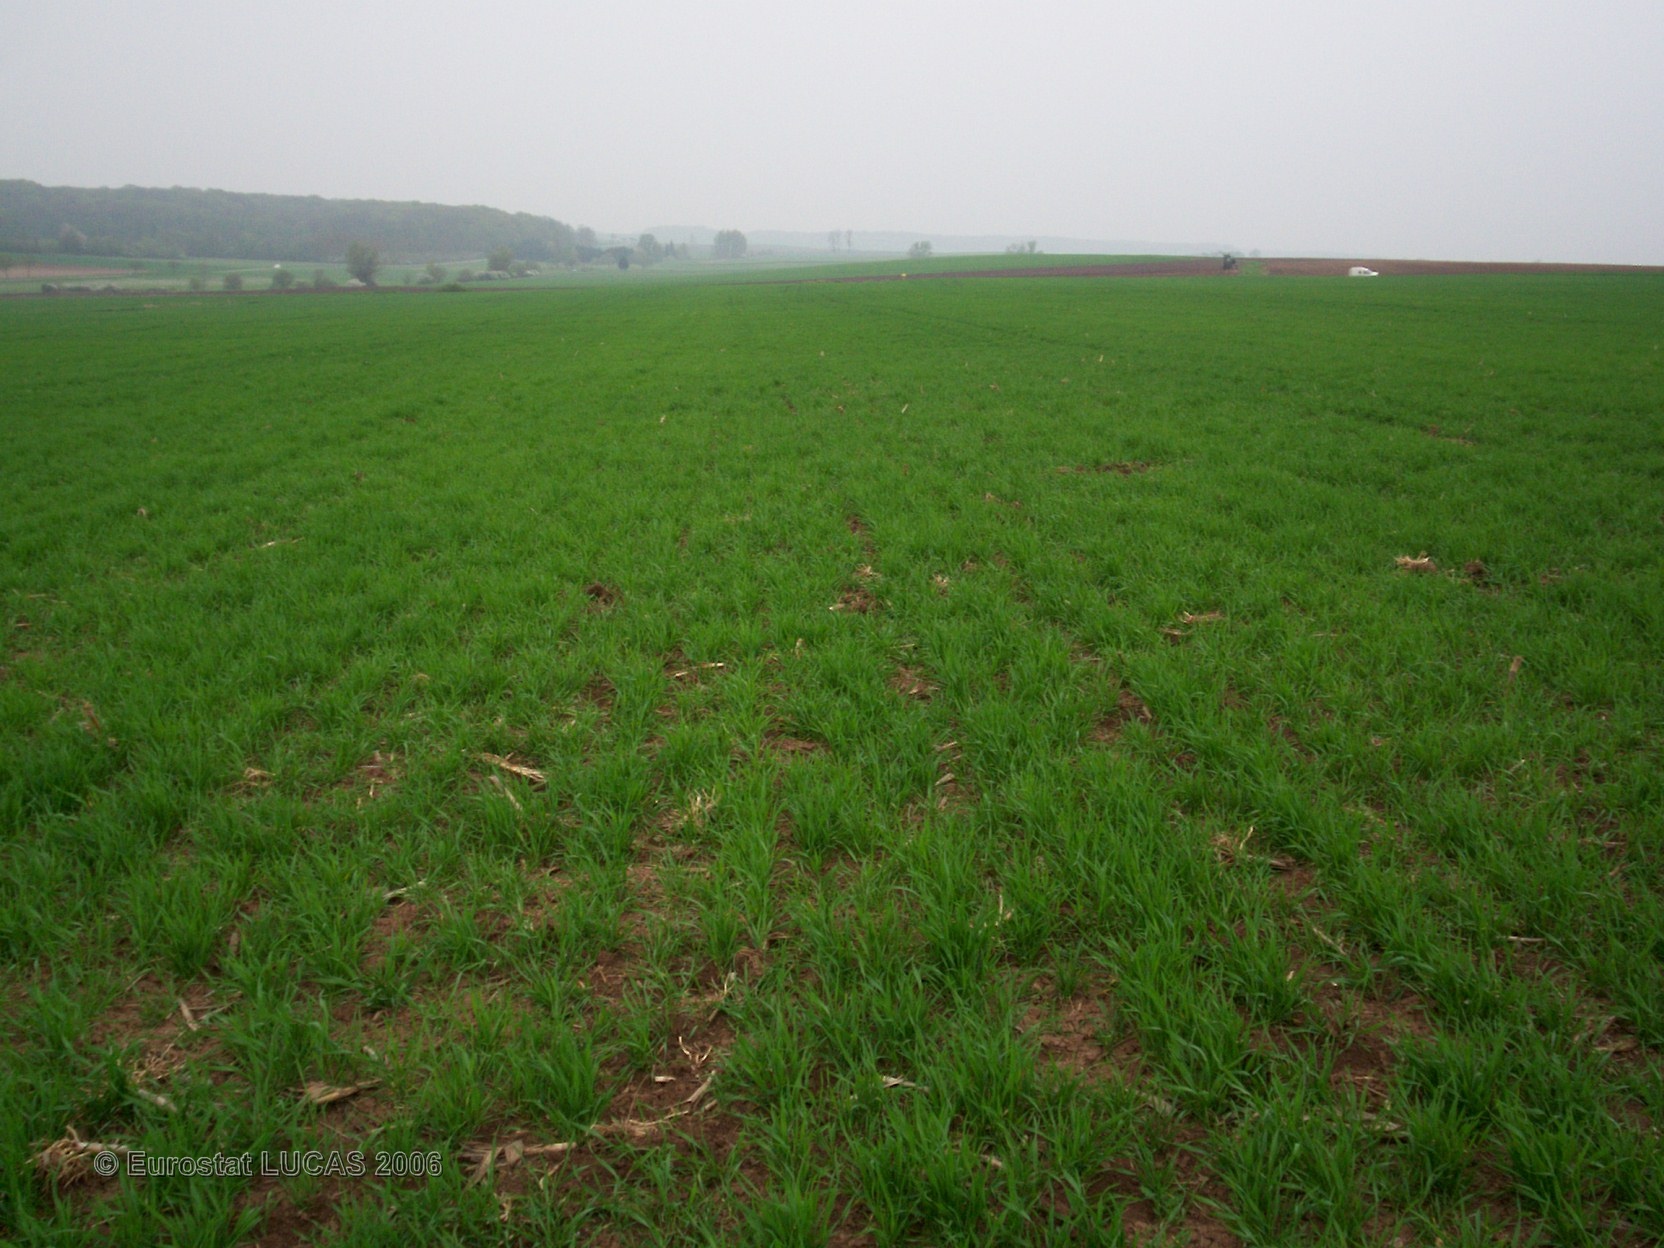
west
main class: Cropland
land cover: Common wheat
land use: Agriculture (excluding fallow land and kitchen gardens)
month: April
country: FR
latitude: 48.9496
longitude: 6.7367
